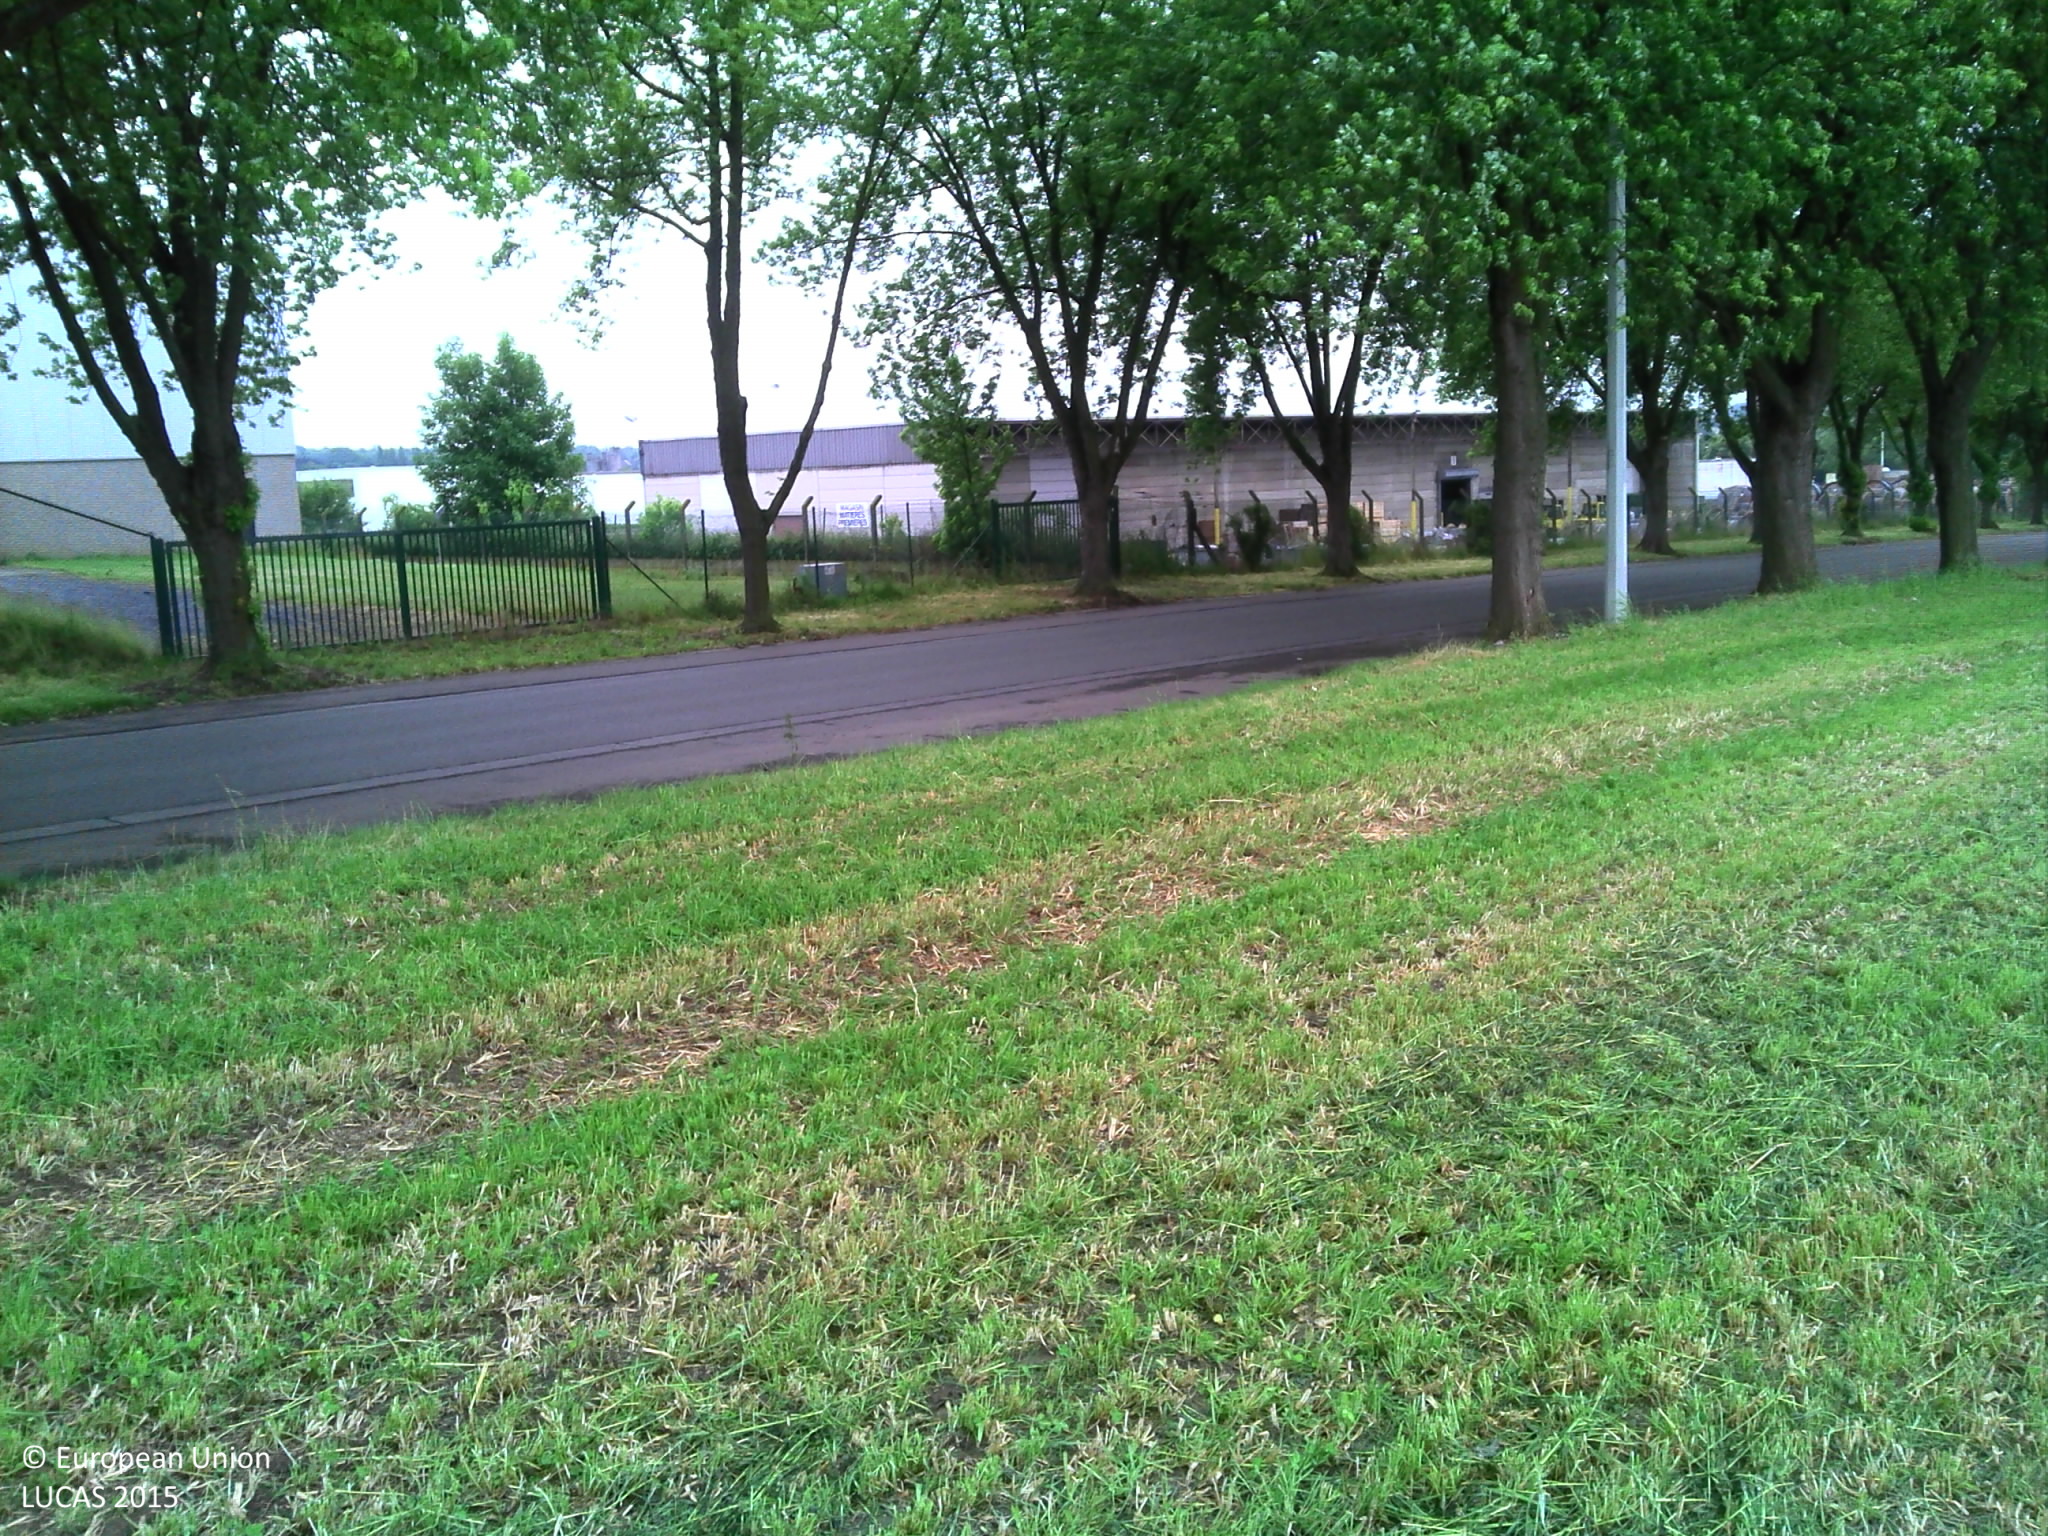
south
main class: Cropland
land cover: Temporary grasslands
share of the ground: > 75 %
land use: Agriculture (excluding fallow land and kitchen gardens)
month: June
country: BE
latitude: 50.4101
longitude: 3.7597
